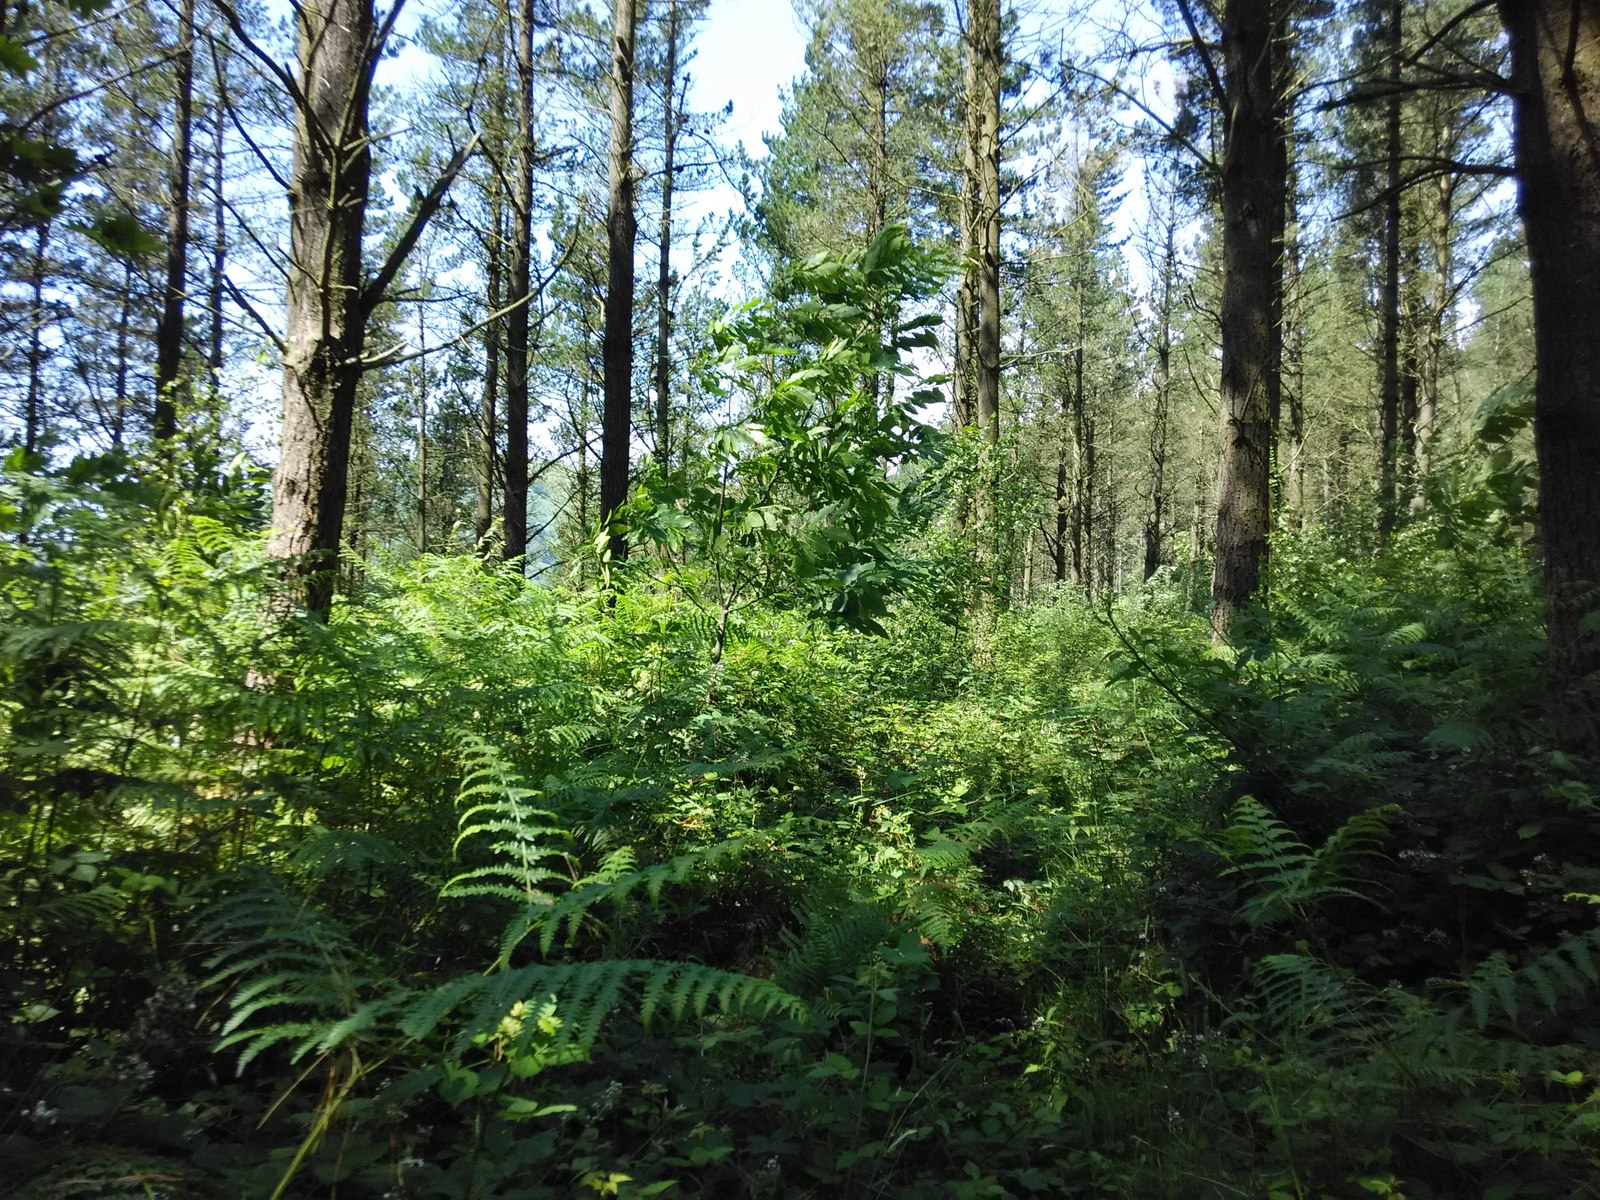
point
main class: Woodland
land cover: Pine dominated coniferous woodland
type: exotic forest
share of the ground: > 75 %
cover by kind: coniferous forest trees 100 %
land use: Forestry
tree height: > 5 m
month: July
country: ES
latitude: 43.1438
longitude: -2.2831
